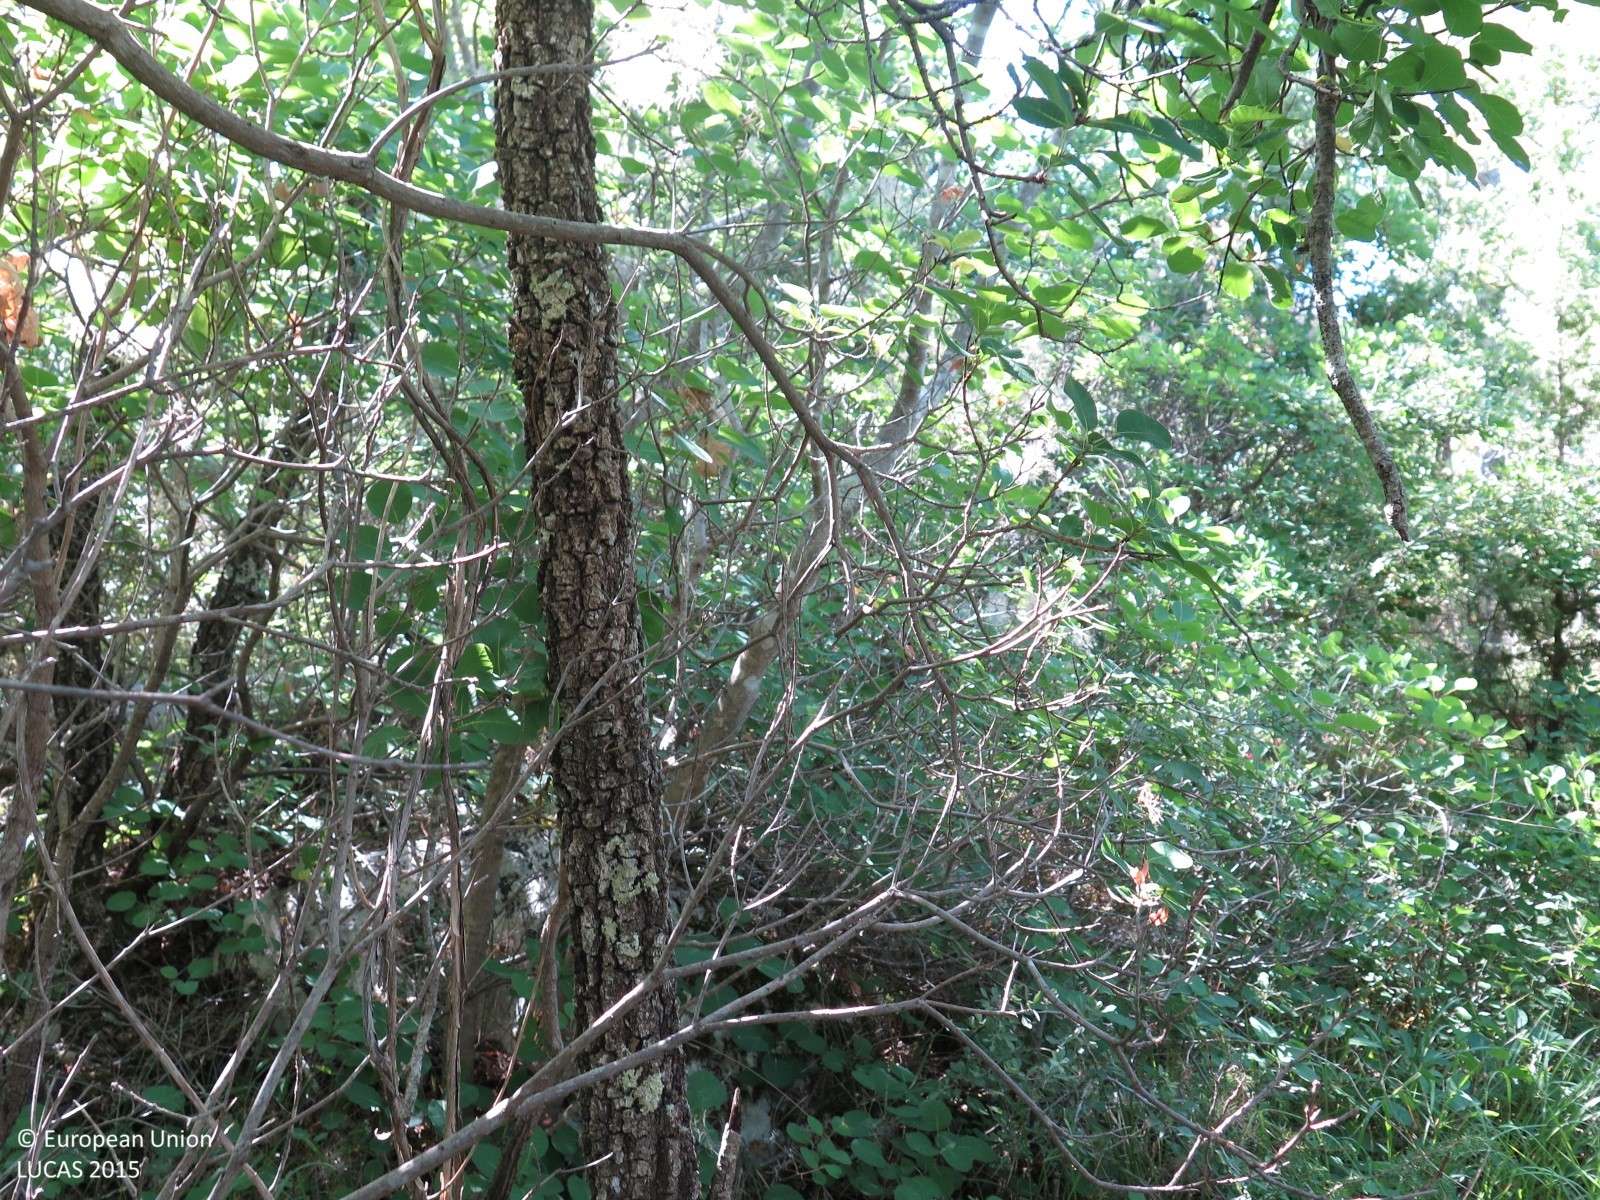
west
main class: Woodland
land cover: Broadleaved woodland
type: acidophilous oak and oak-birch forest
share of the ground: > 75 %
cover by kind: broadleaved forest trees 95 %, herbaceous plants 5 %
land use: Semi-natural and natural areas not in use
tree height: > 5 m
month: July
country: HR
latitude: 45.4211
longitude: 13.7141
